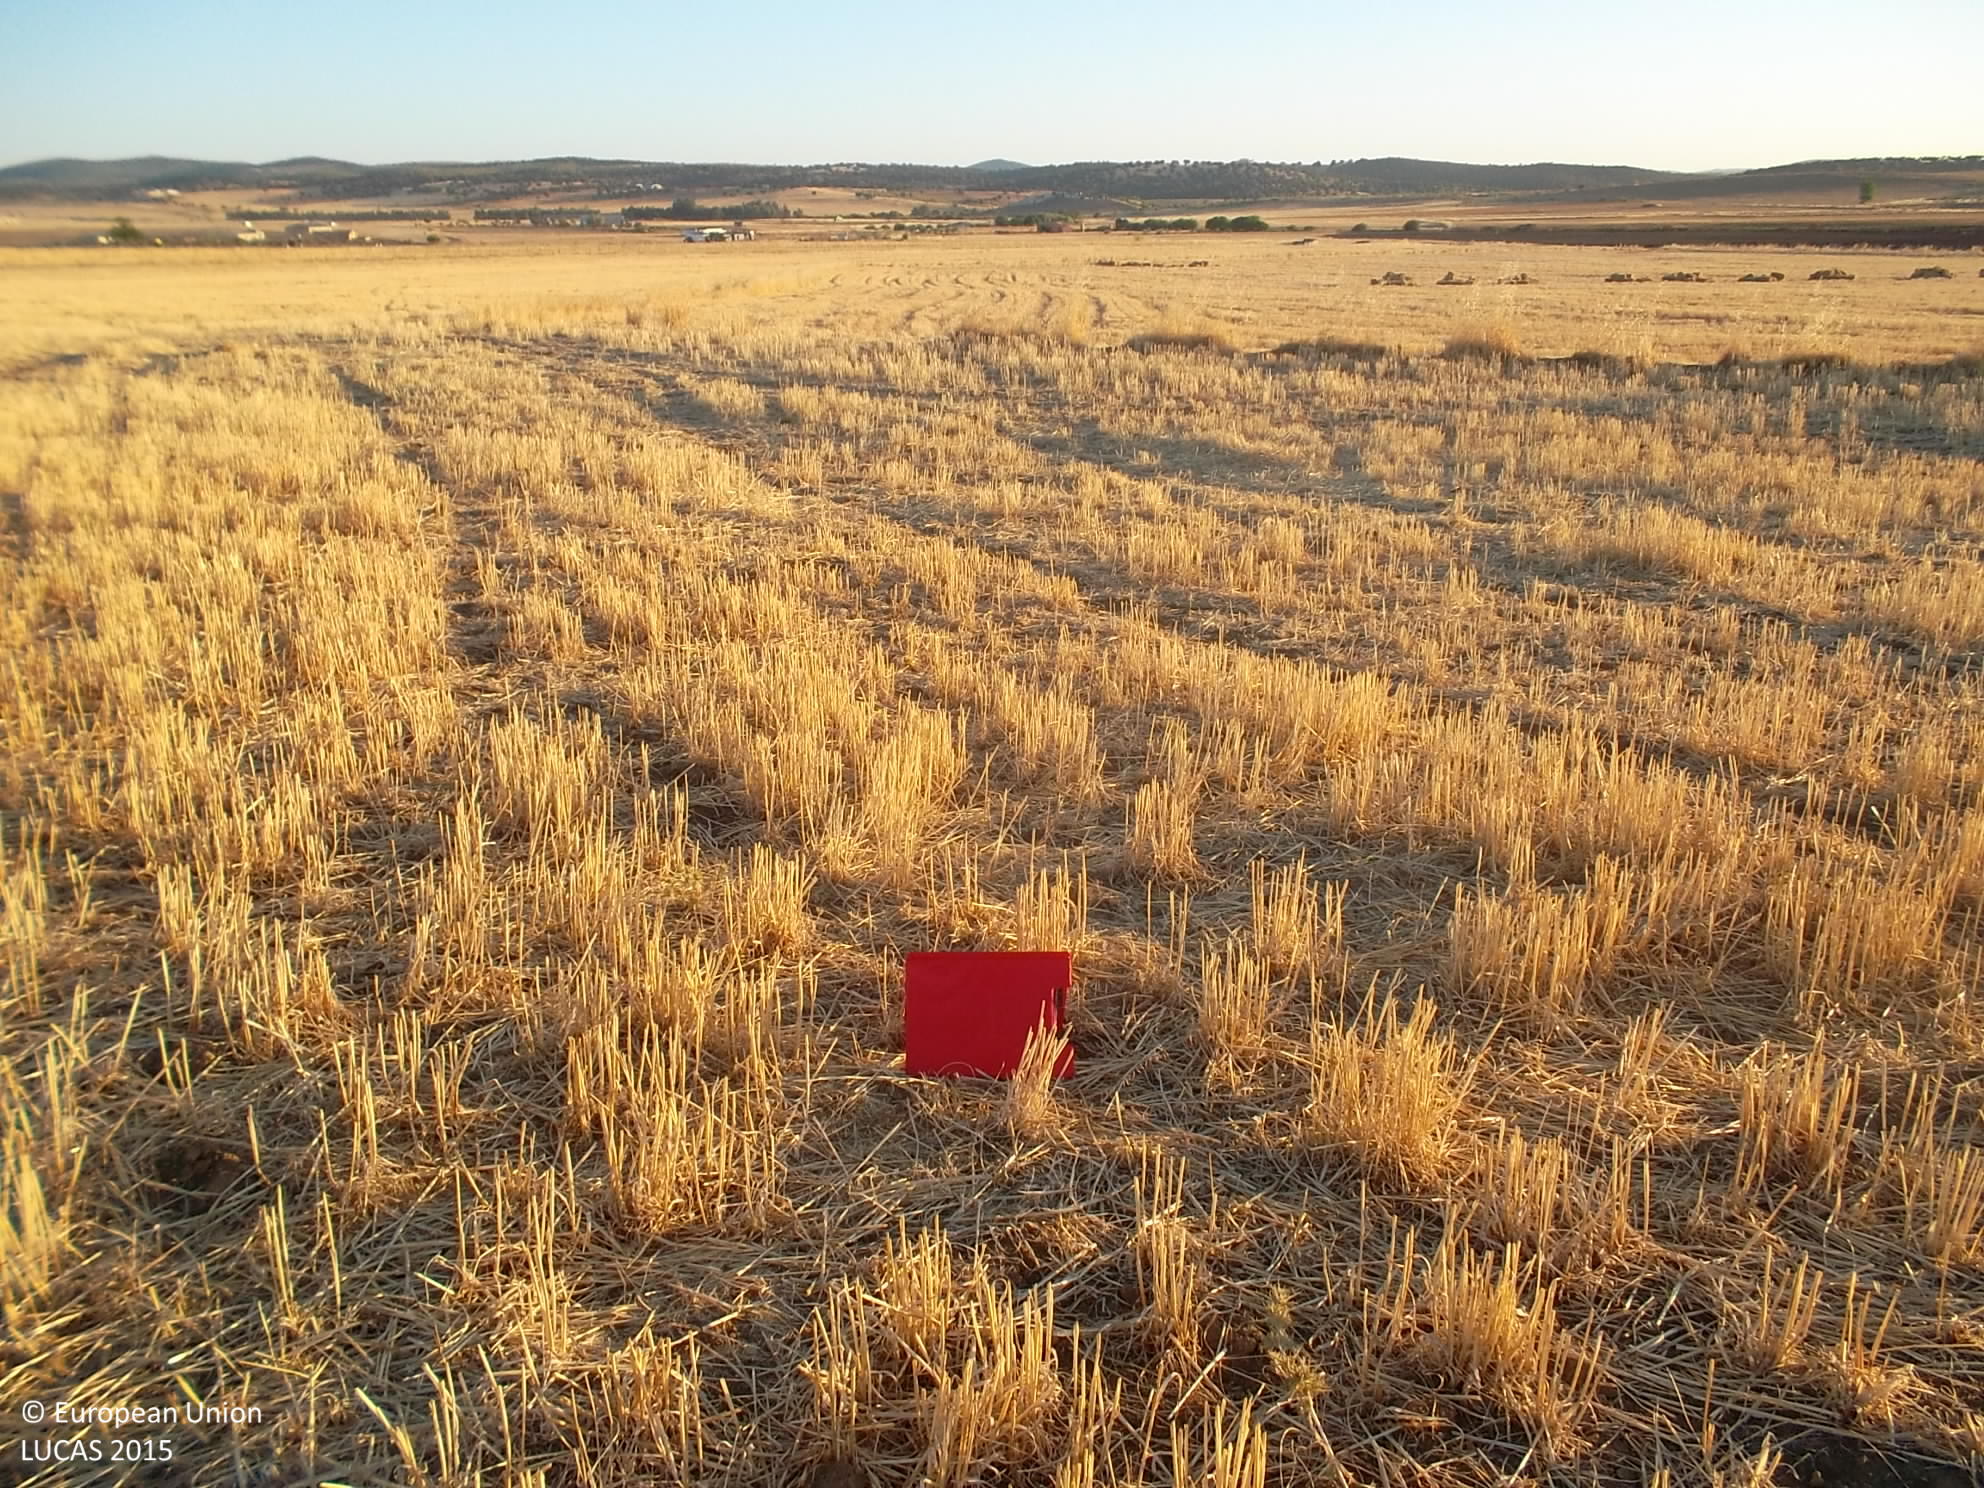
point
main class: Cropland
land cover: Oats
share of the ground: < 10 %
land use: Agriculture (excluding fallow land and kitchen gardens)
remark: Harvested field
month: July
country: ES
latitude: 38.5123
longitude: -5.8331
